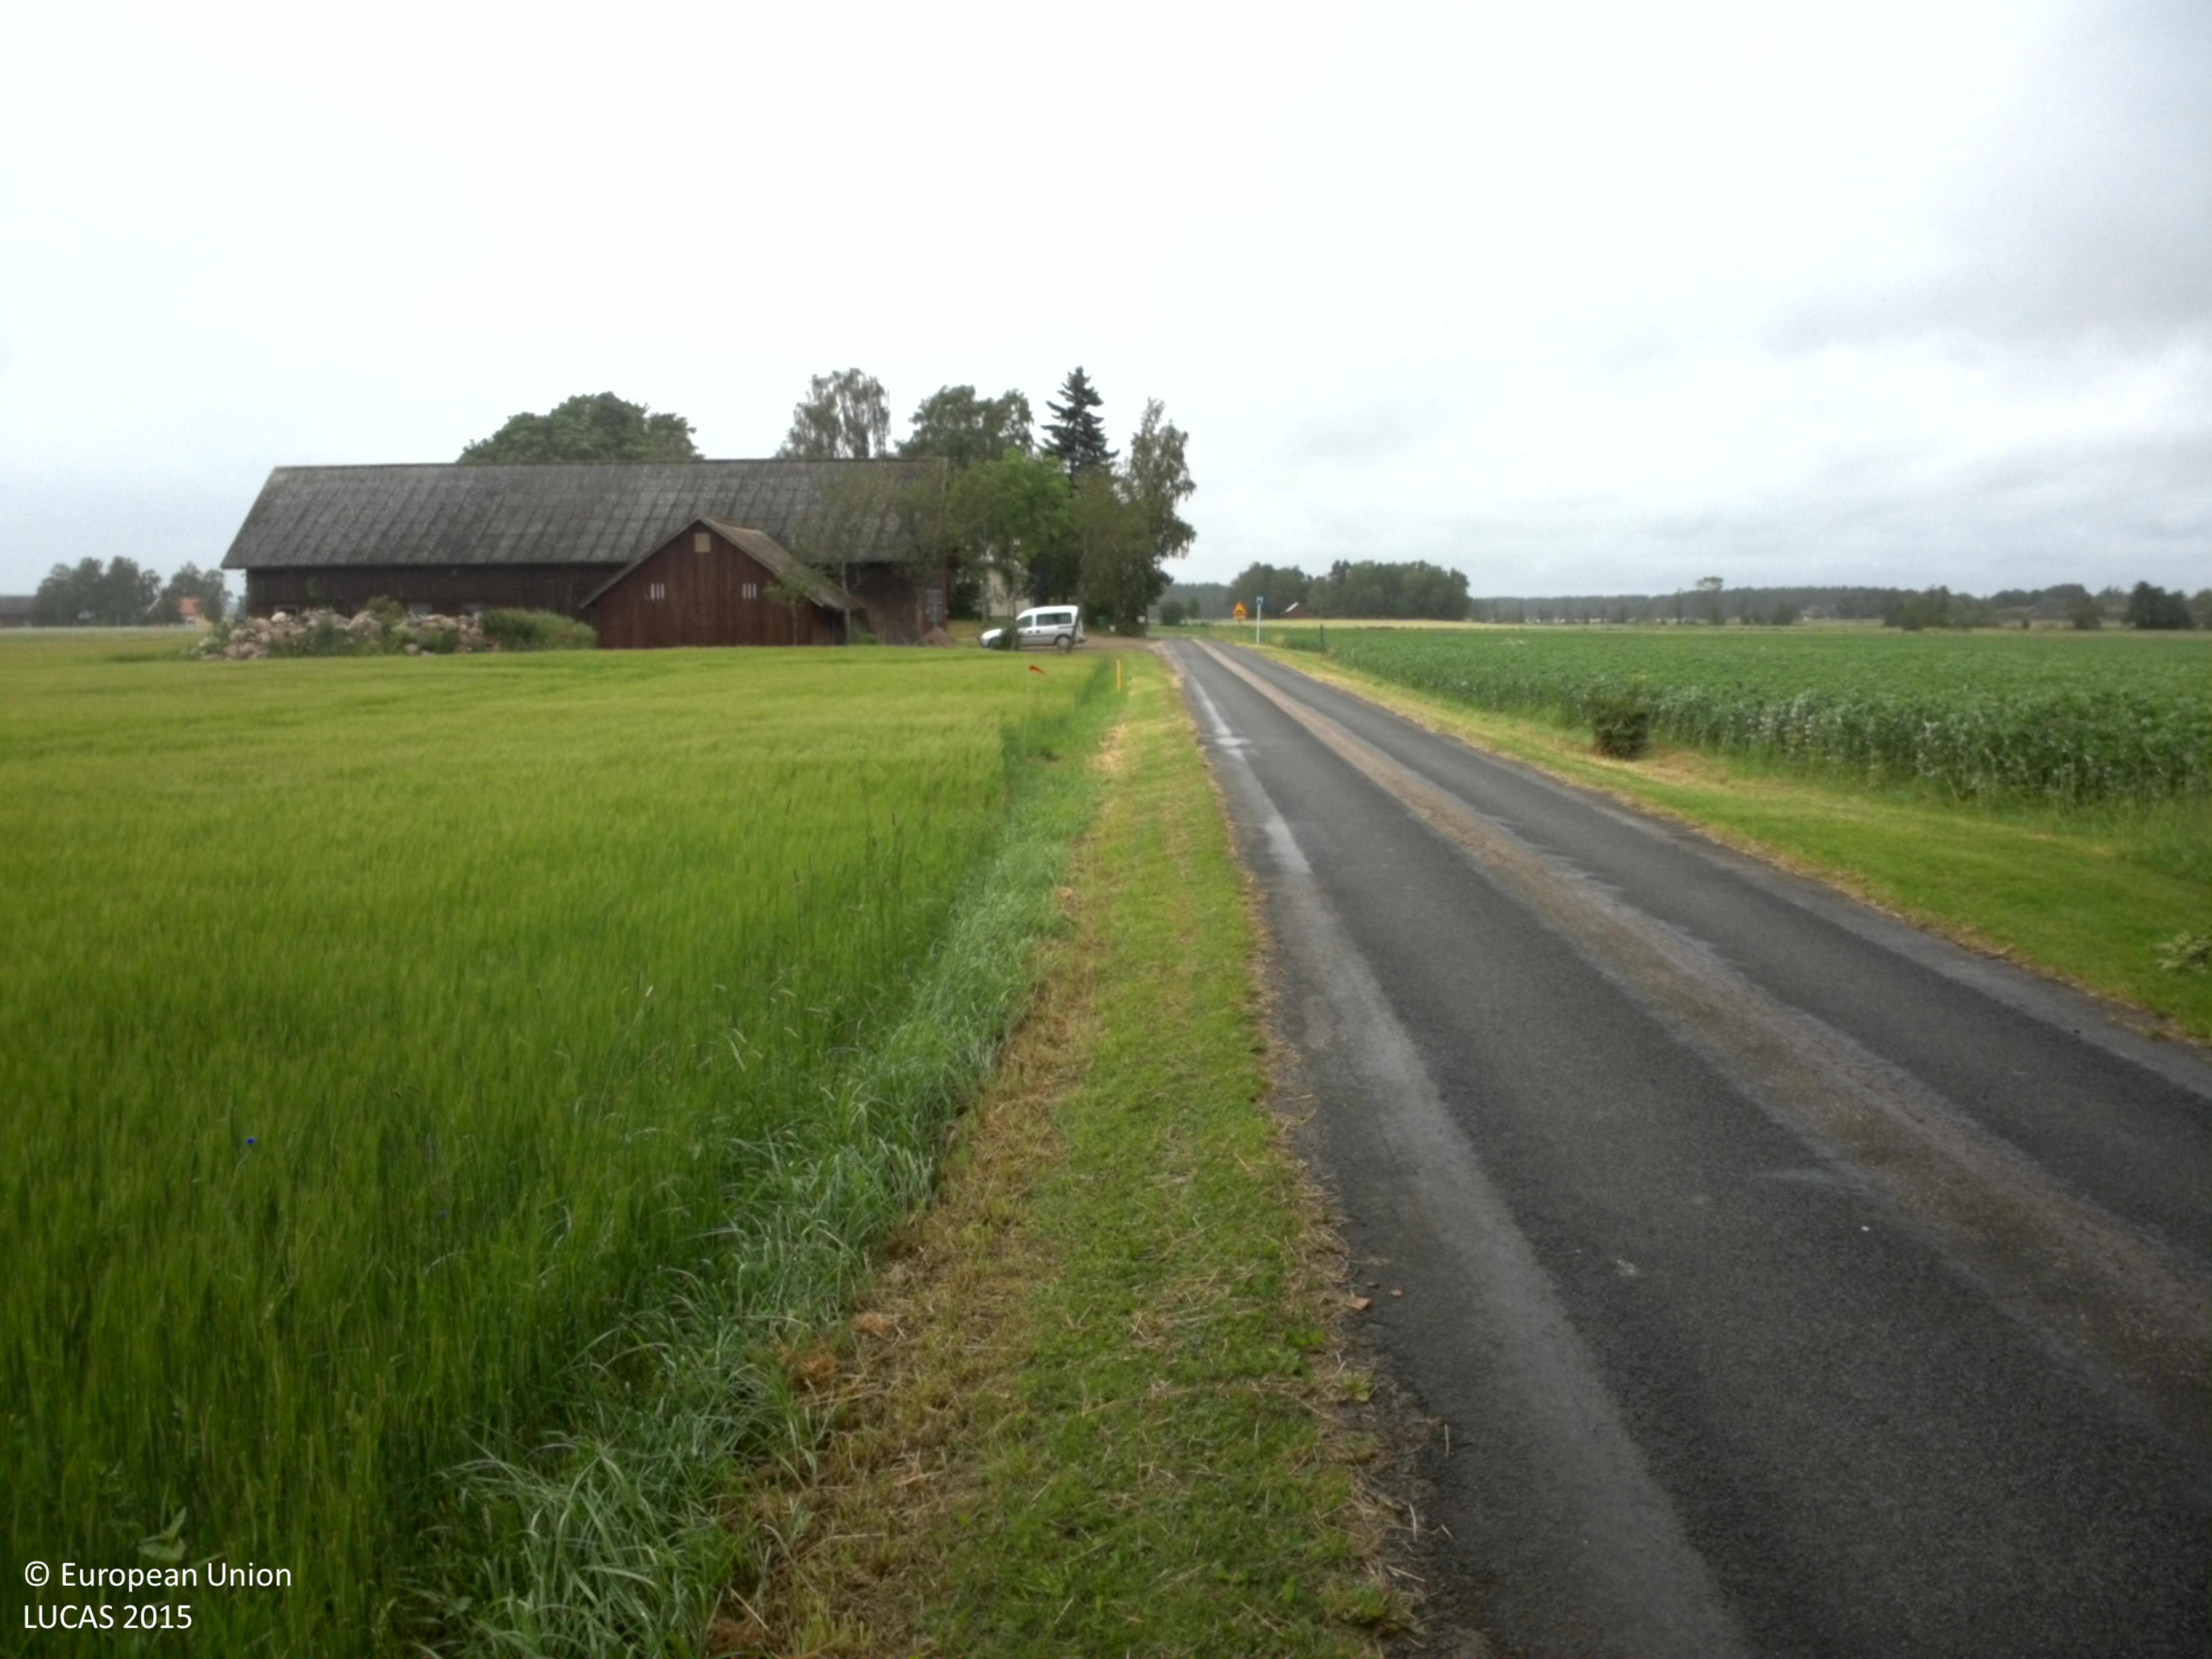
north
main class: Cropland
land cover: Barley
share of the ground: > 75 %
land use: Agriculture (excluding fallow land and kitchen gardens)
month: July
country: SE
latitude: 58.5045
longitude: 13.9235
